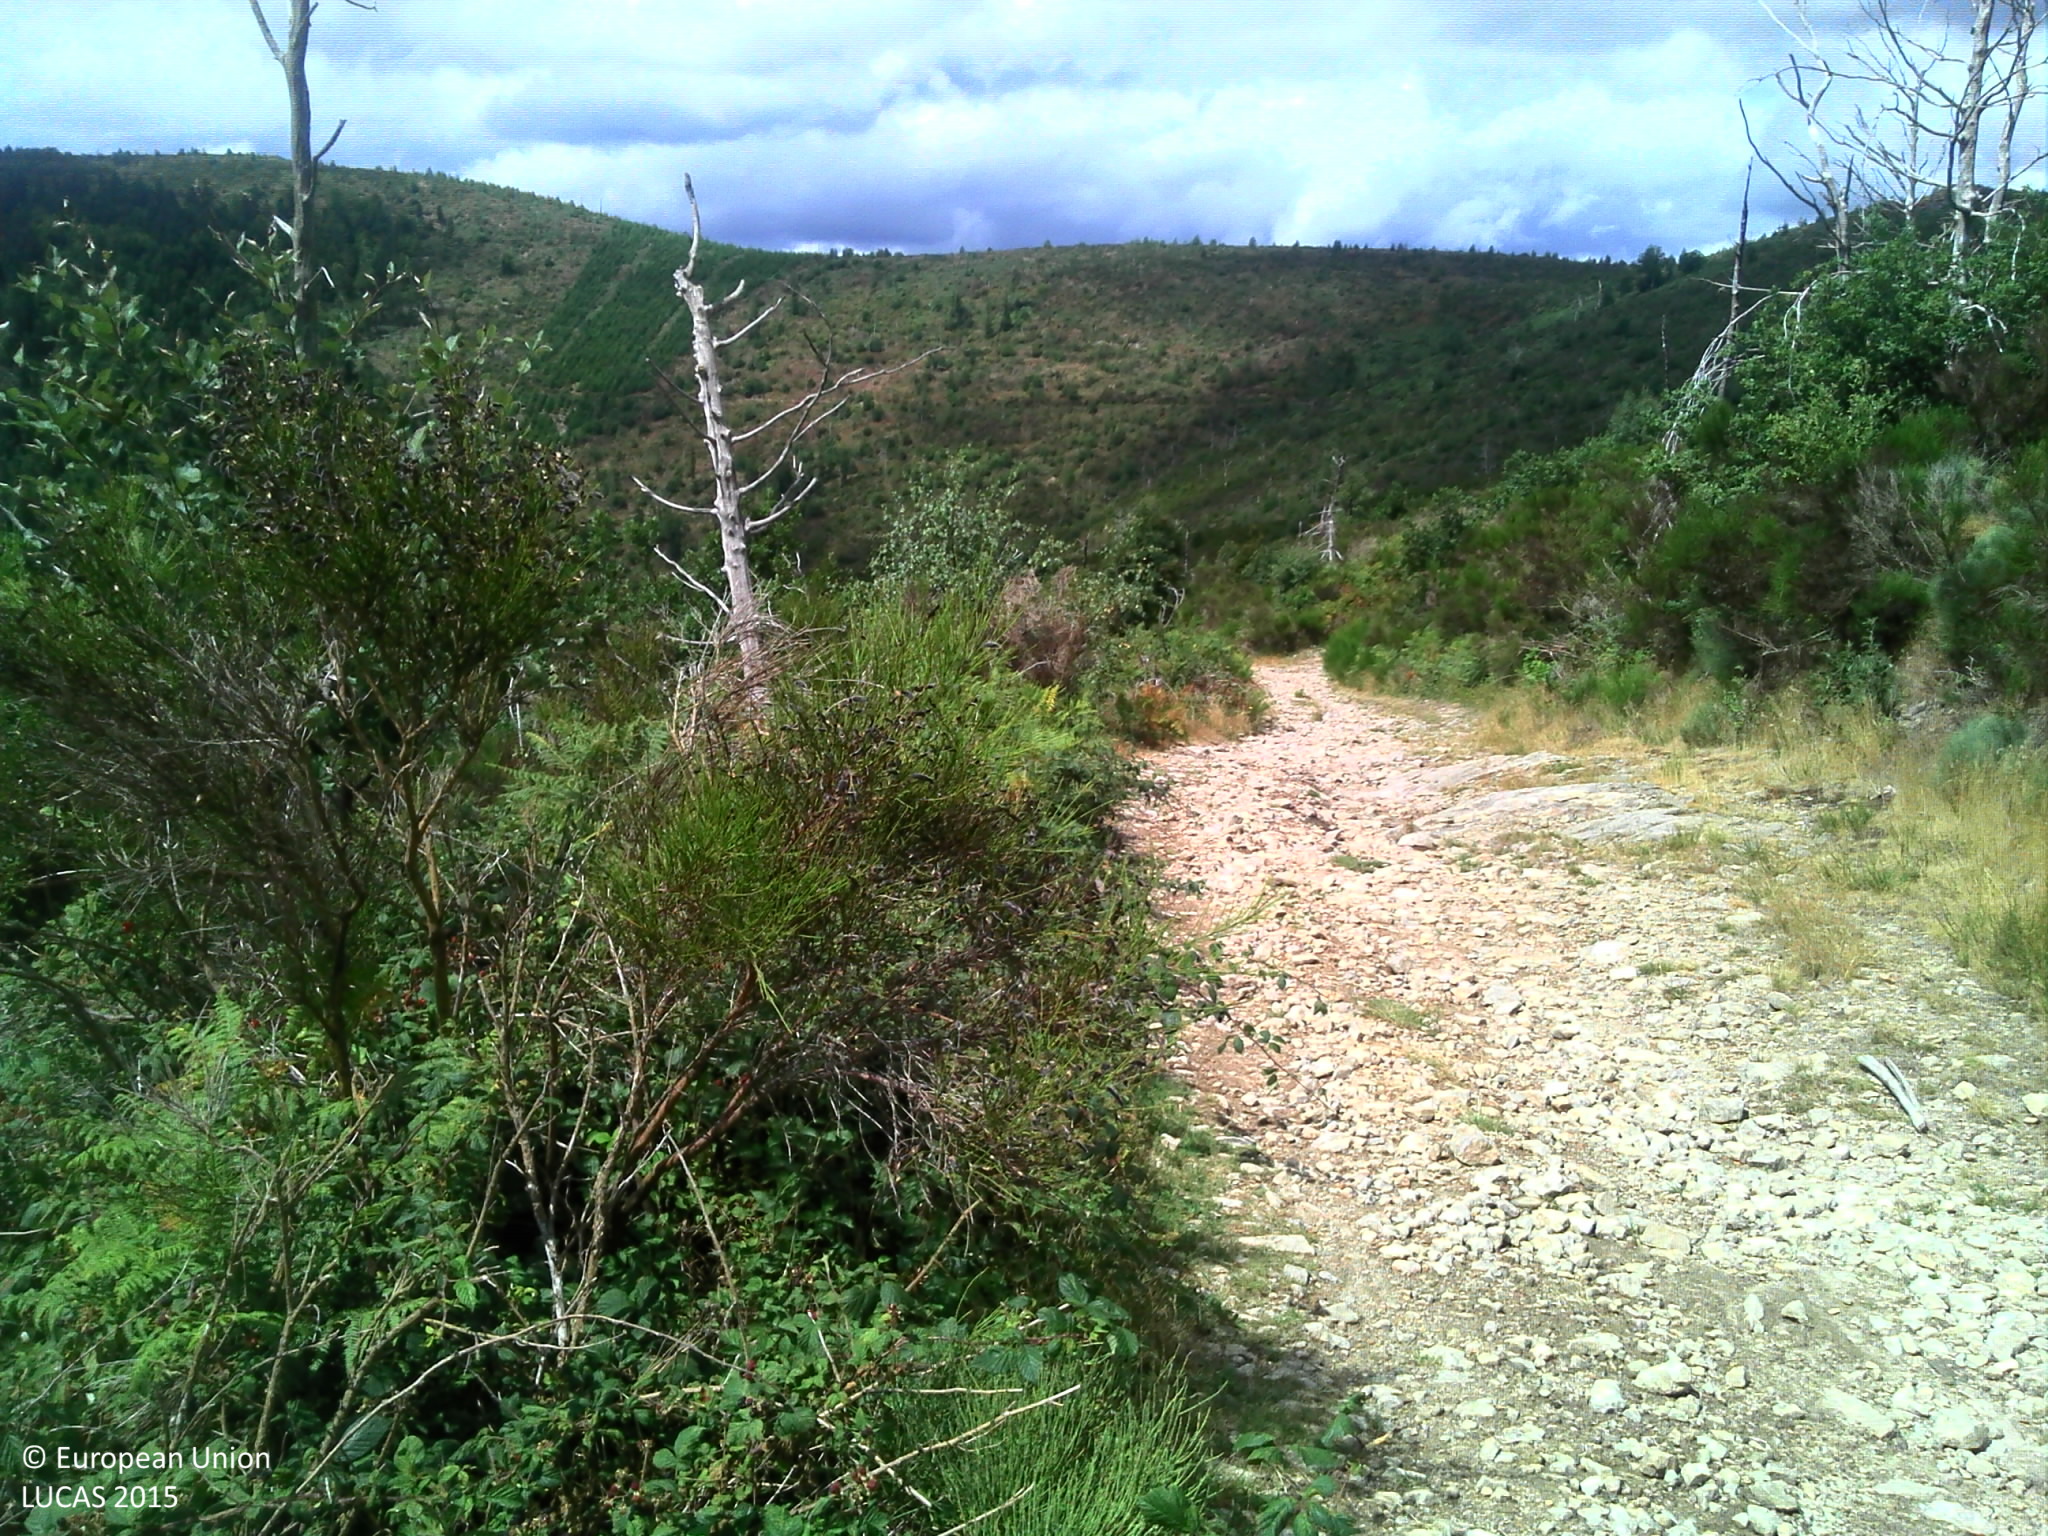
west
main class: Shrubland
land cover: Shrubland with sparse tree cover
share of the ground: > 75 %
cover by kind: shrubs 95 %, broadleaved forest trees 5 %
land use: Semi-natural and natural areas not in use
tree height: < 5 m
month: August
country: FR
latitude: 45.0929
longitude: 4.5539
